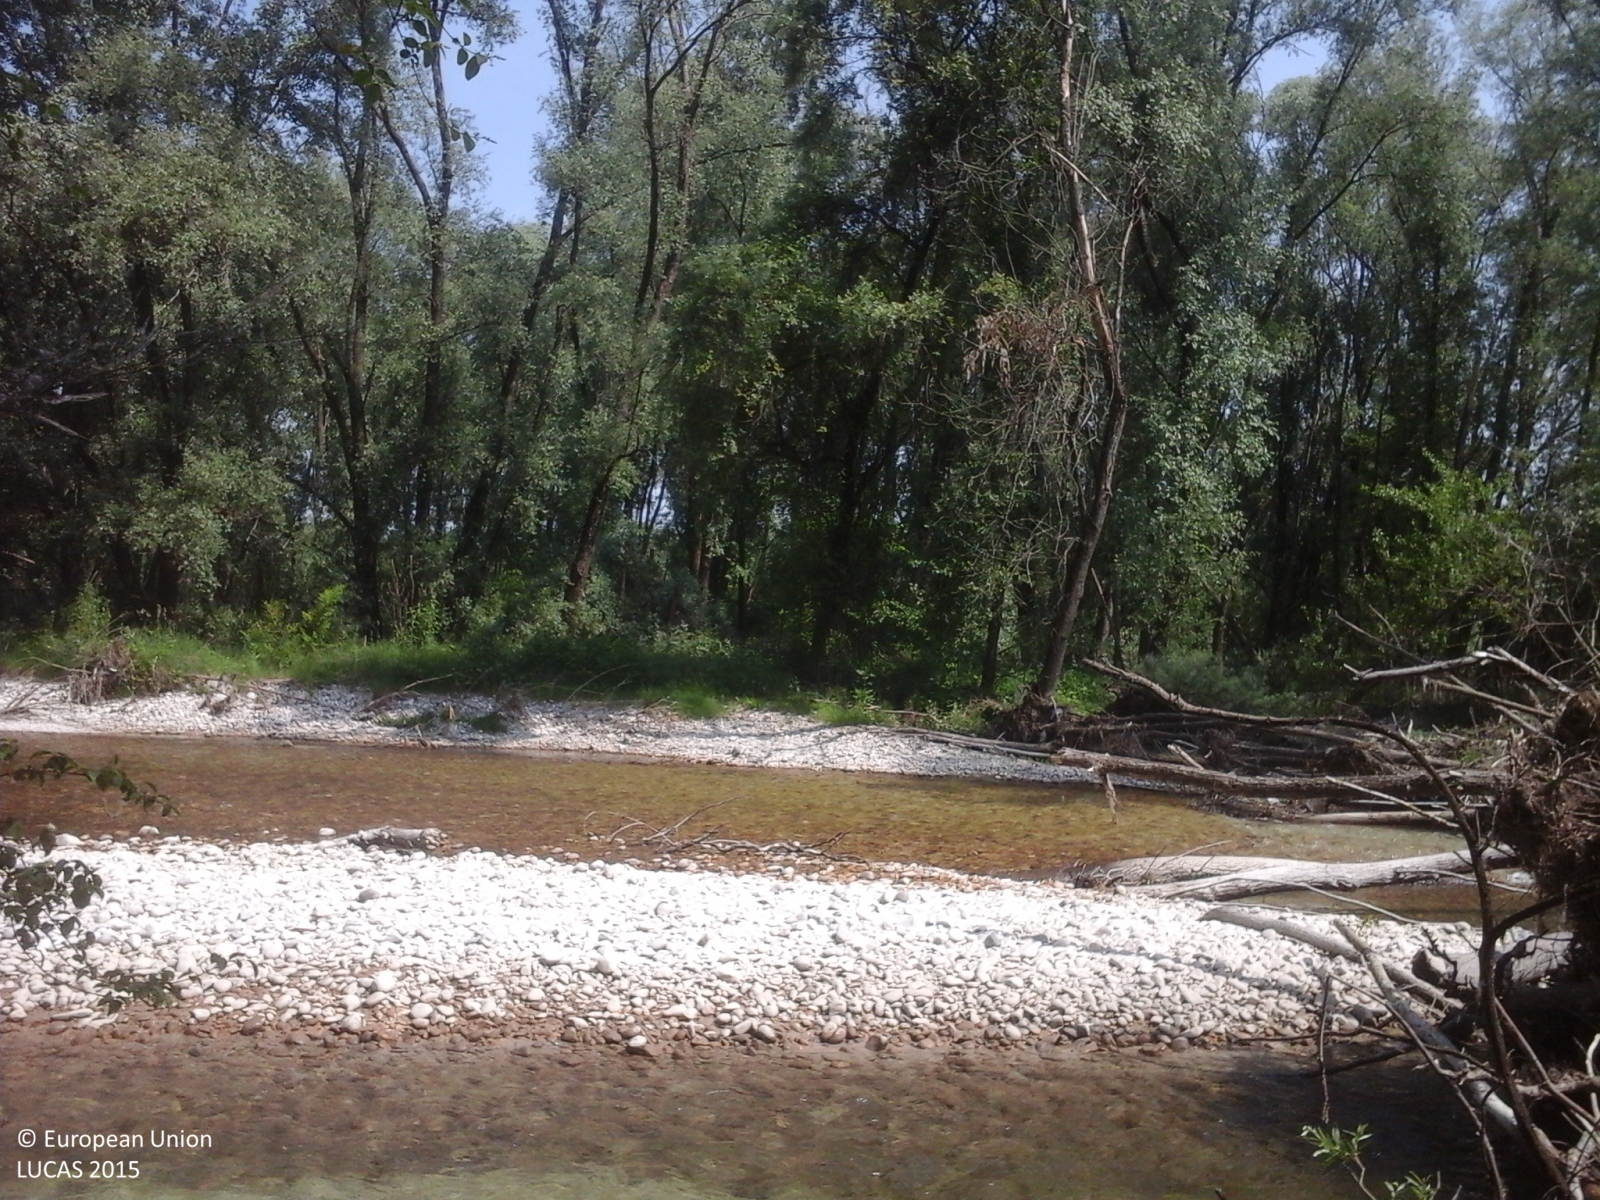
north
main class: Woodland
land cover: Broadleaved woodland
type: thermophilous deciduous forest
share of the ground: > 75 %
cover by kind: broadleaved forest trees 100 %
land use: Semi-natural and natural areas not in use
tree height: > 5 m
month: May
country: IT
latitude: 45.6345
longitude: 11.7291
